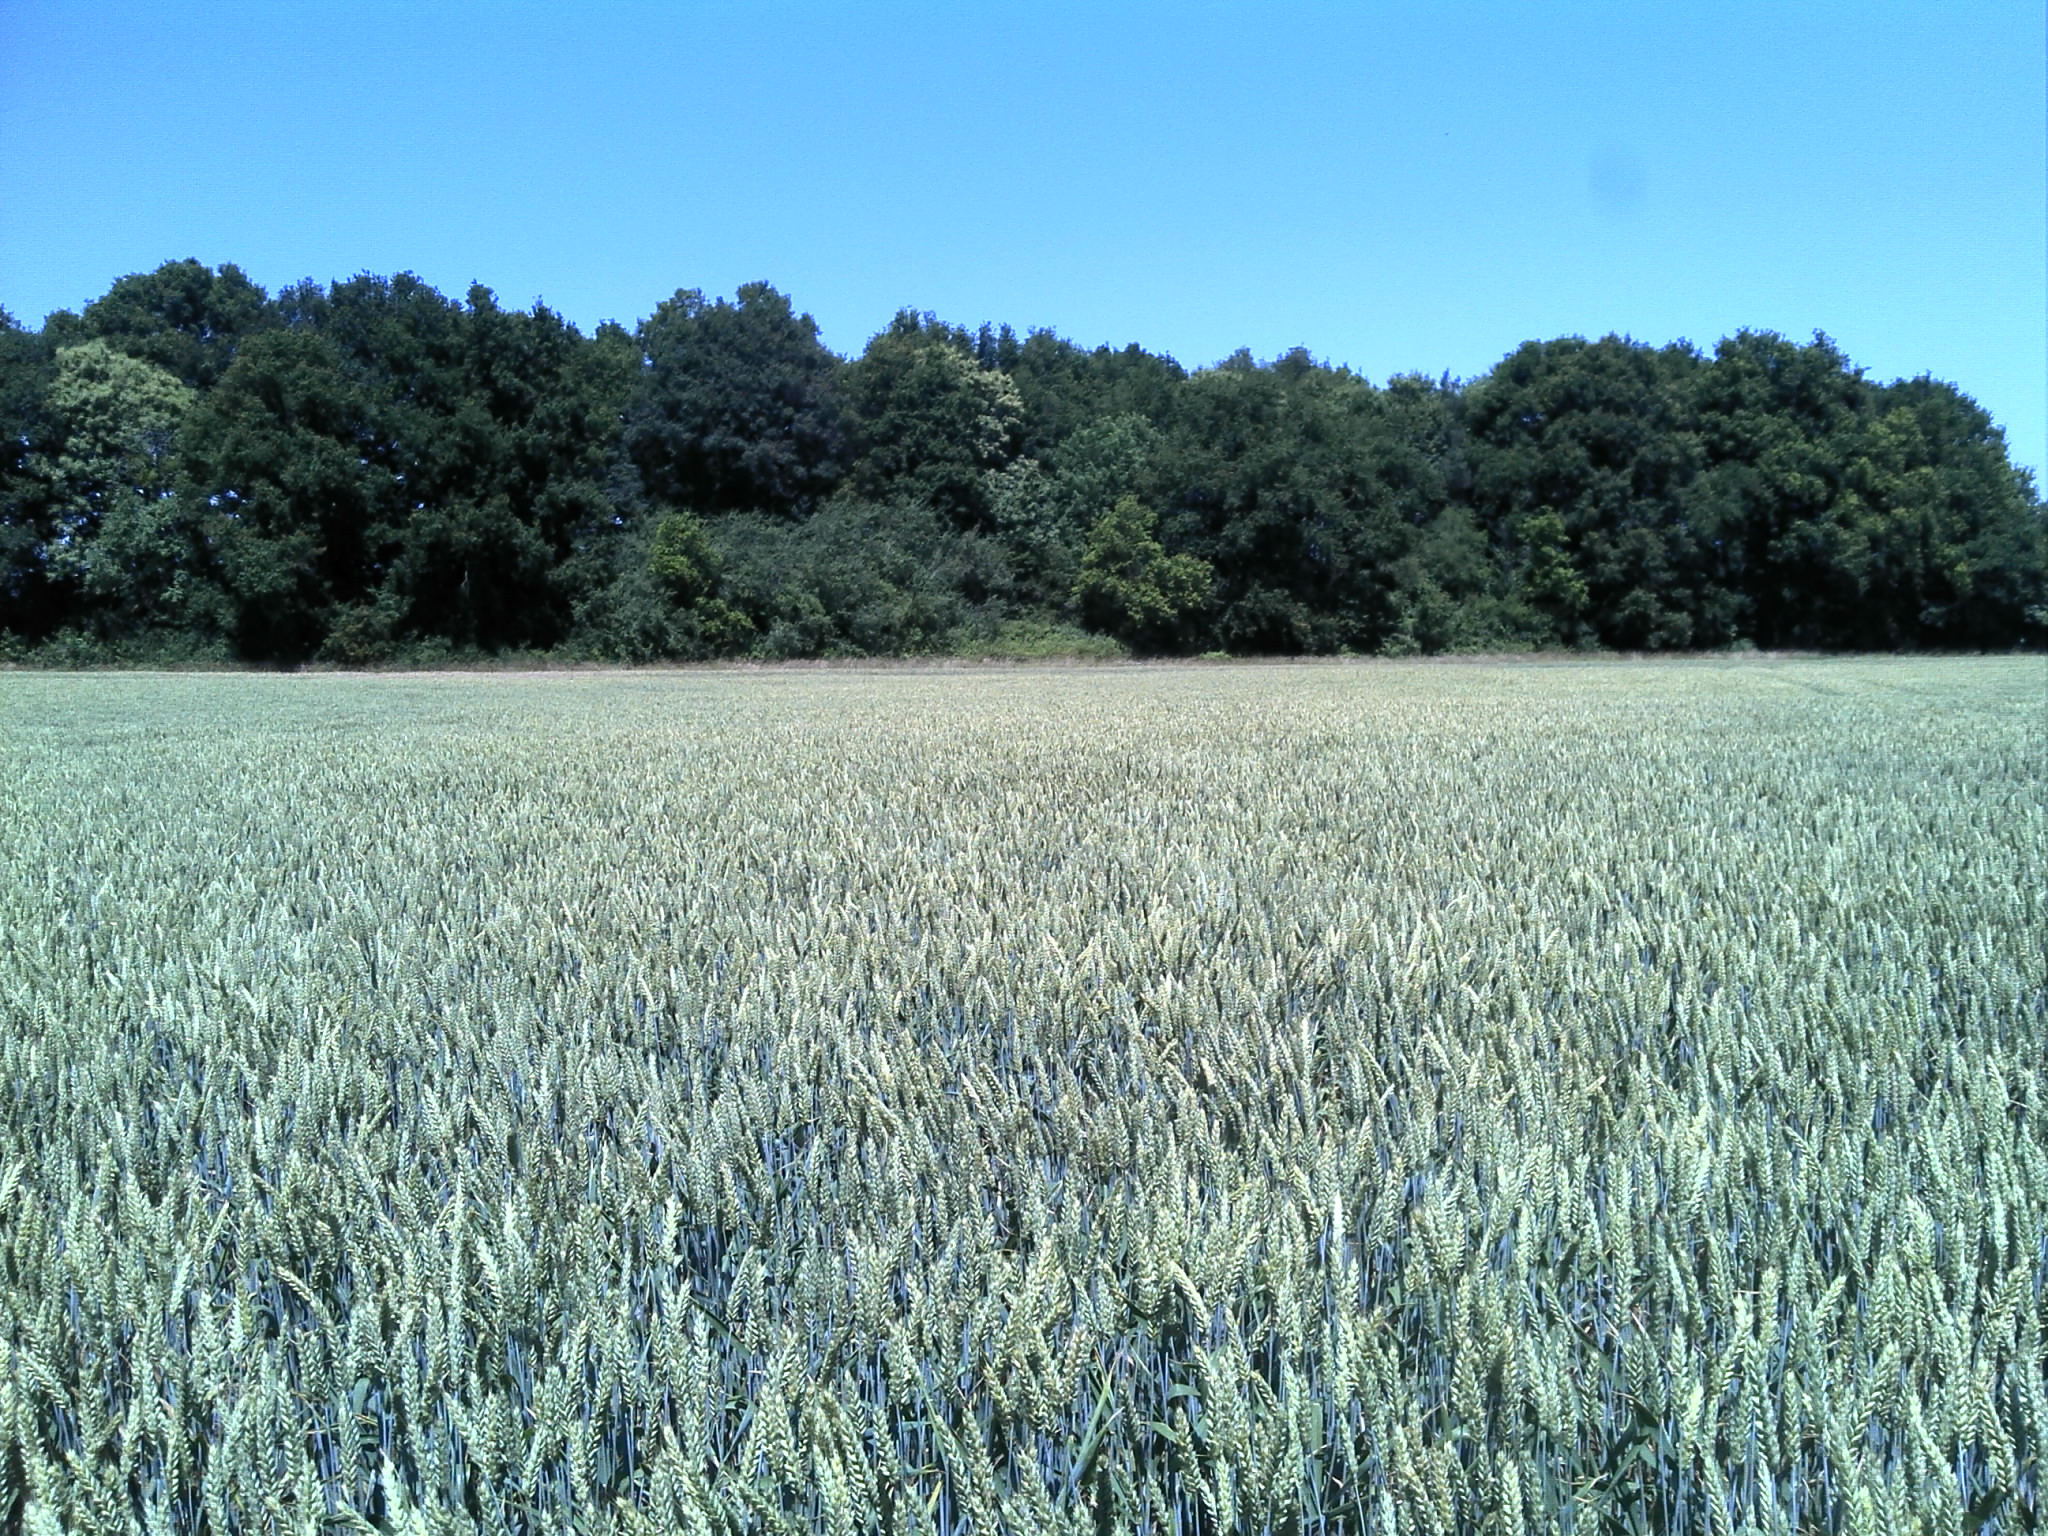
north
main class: Cropland
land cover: Common wheat
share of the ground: > 75 %
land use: Agriculture (excluding fallow land and kitchen gardens)
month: June
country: FR
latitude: 47.1651
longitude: 1.4254
